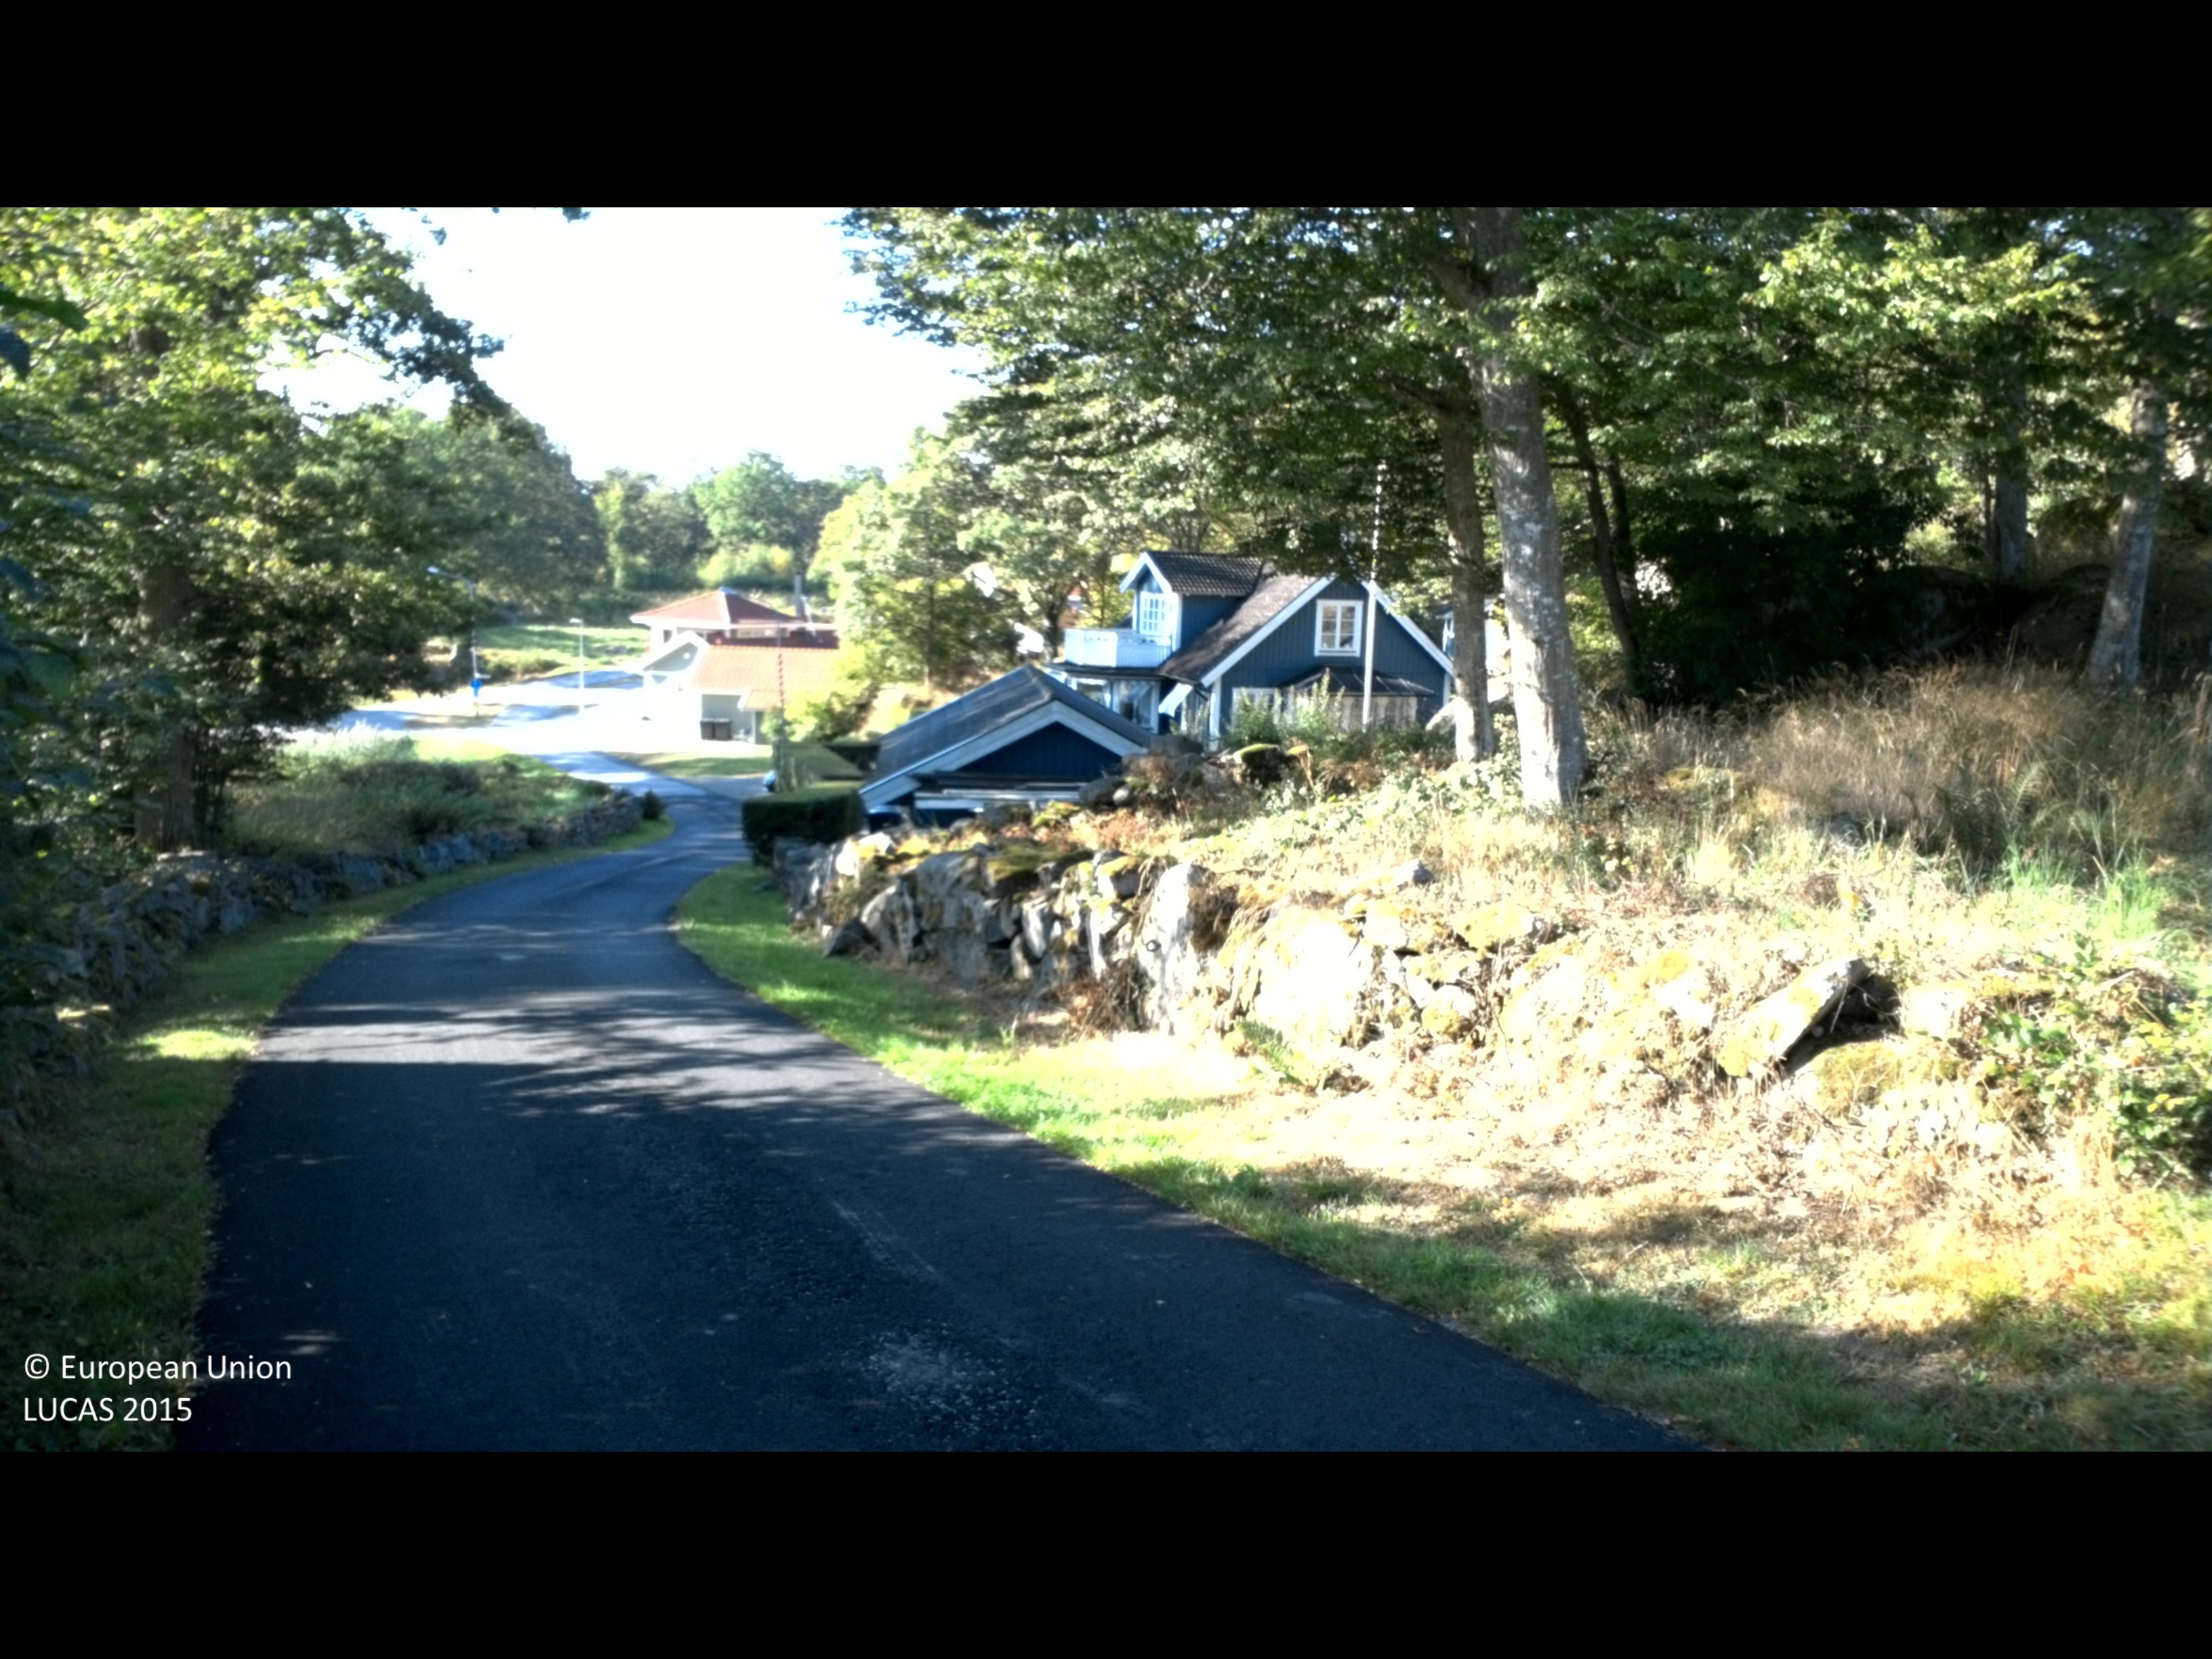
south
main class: Shrubland
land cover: Shrubland with sparse tree cover
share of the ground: > 75 %
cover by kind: shrubs 80 %, herbaceous plants 15 %, broadleaved forest trees 5 %
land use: Residential
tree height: < 5 m
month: August
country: SE
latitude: 56.1981
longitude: 15.0112
